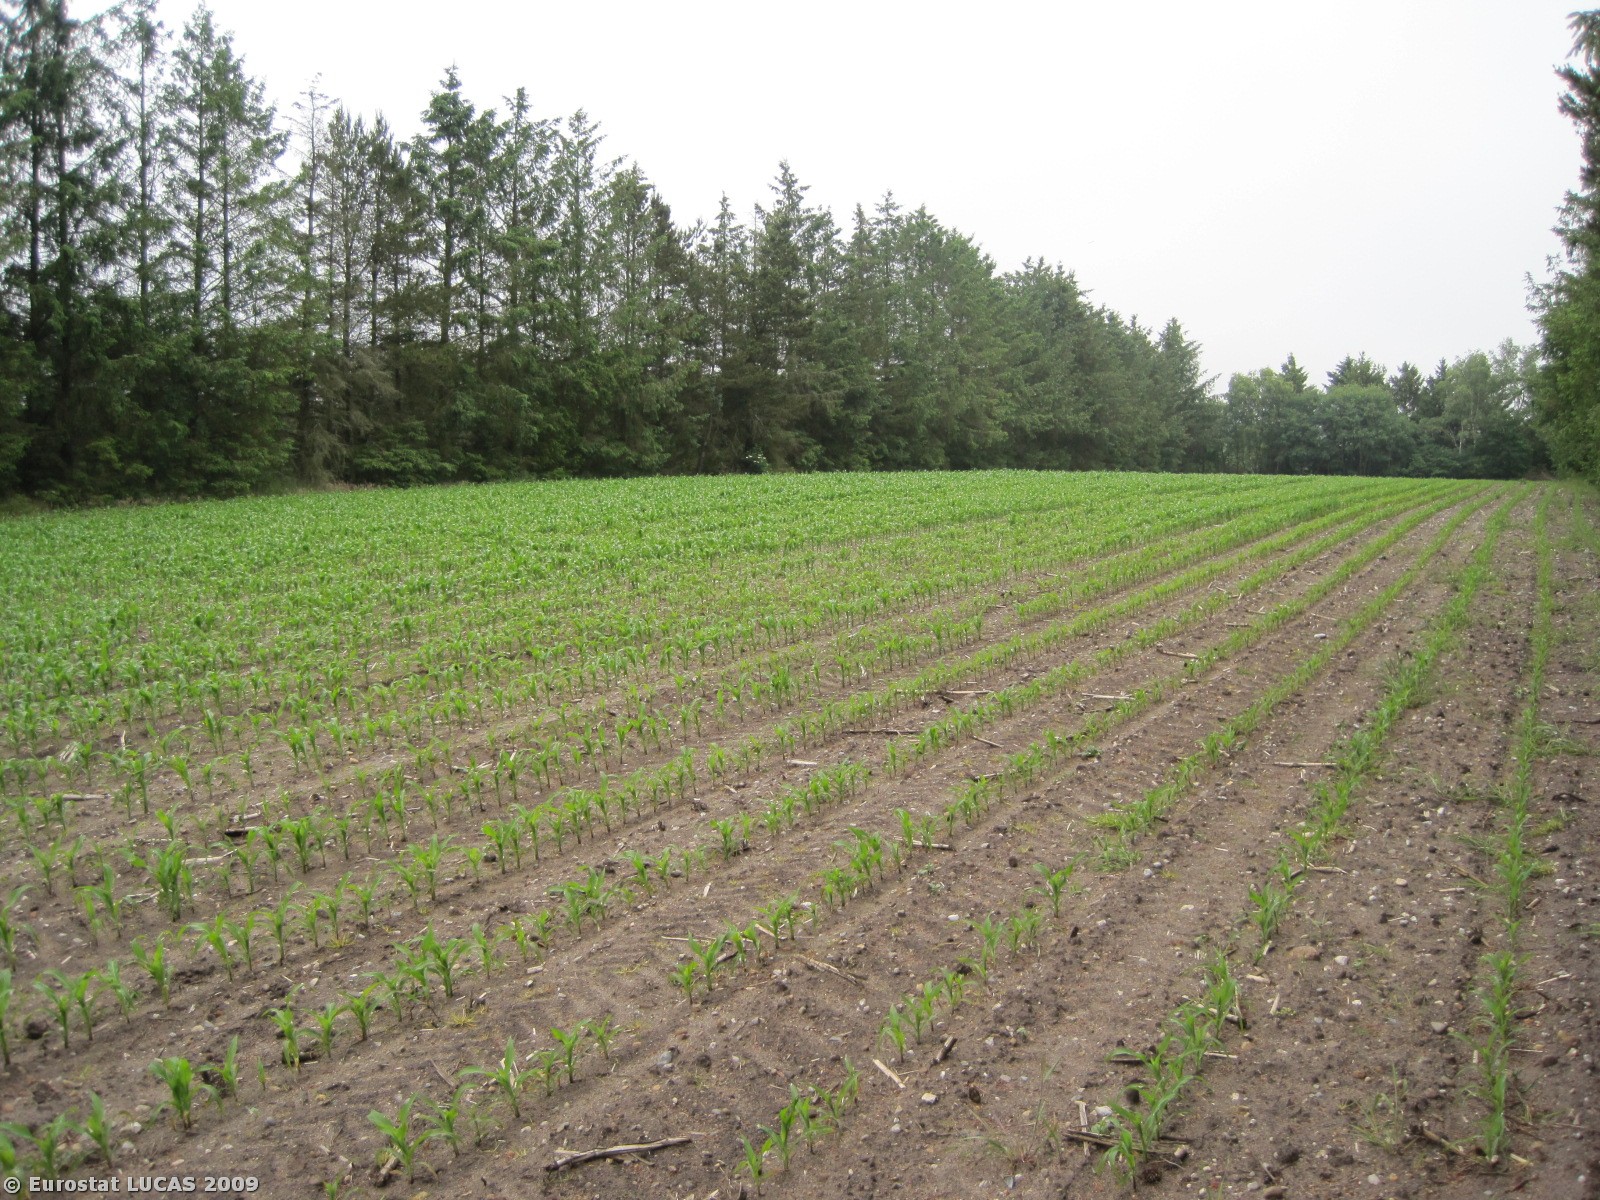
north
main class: Cropland
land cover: Maize
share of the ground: 10 - 25 %
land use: Agriculture (excluding fallow land and kitchen gardens)
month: June
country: DK
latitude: 56.3635
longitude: 8.9815
